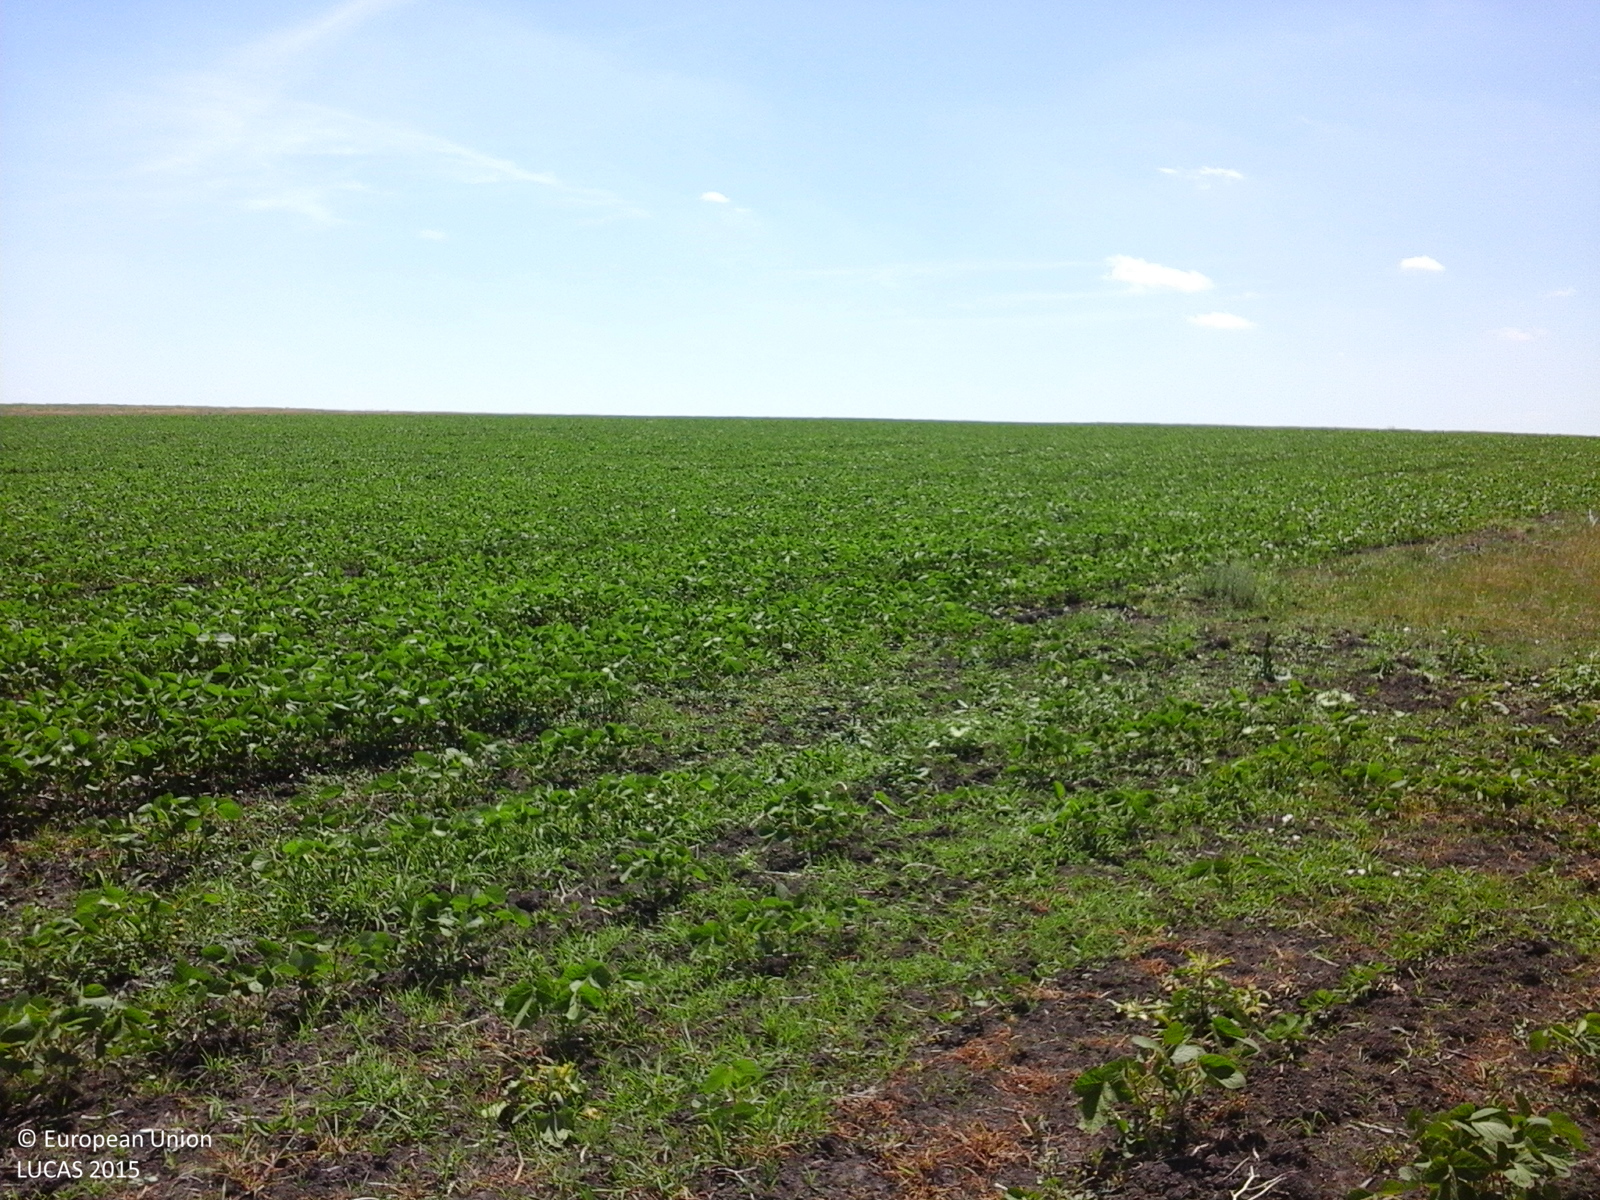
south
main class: Cropland
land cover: Soya
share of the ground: 10 - 25 %
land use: Agriculture (excluding fallow land and kitchen gardens)
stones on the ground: < 10 %
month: June
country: RO
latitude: 48.1248
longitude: 26.7457
